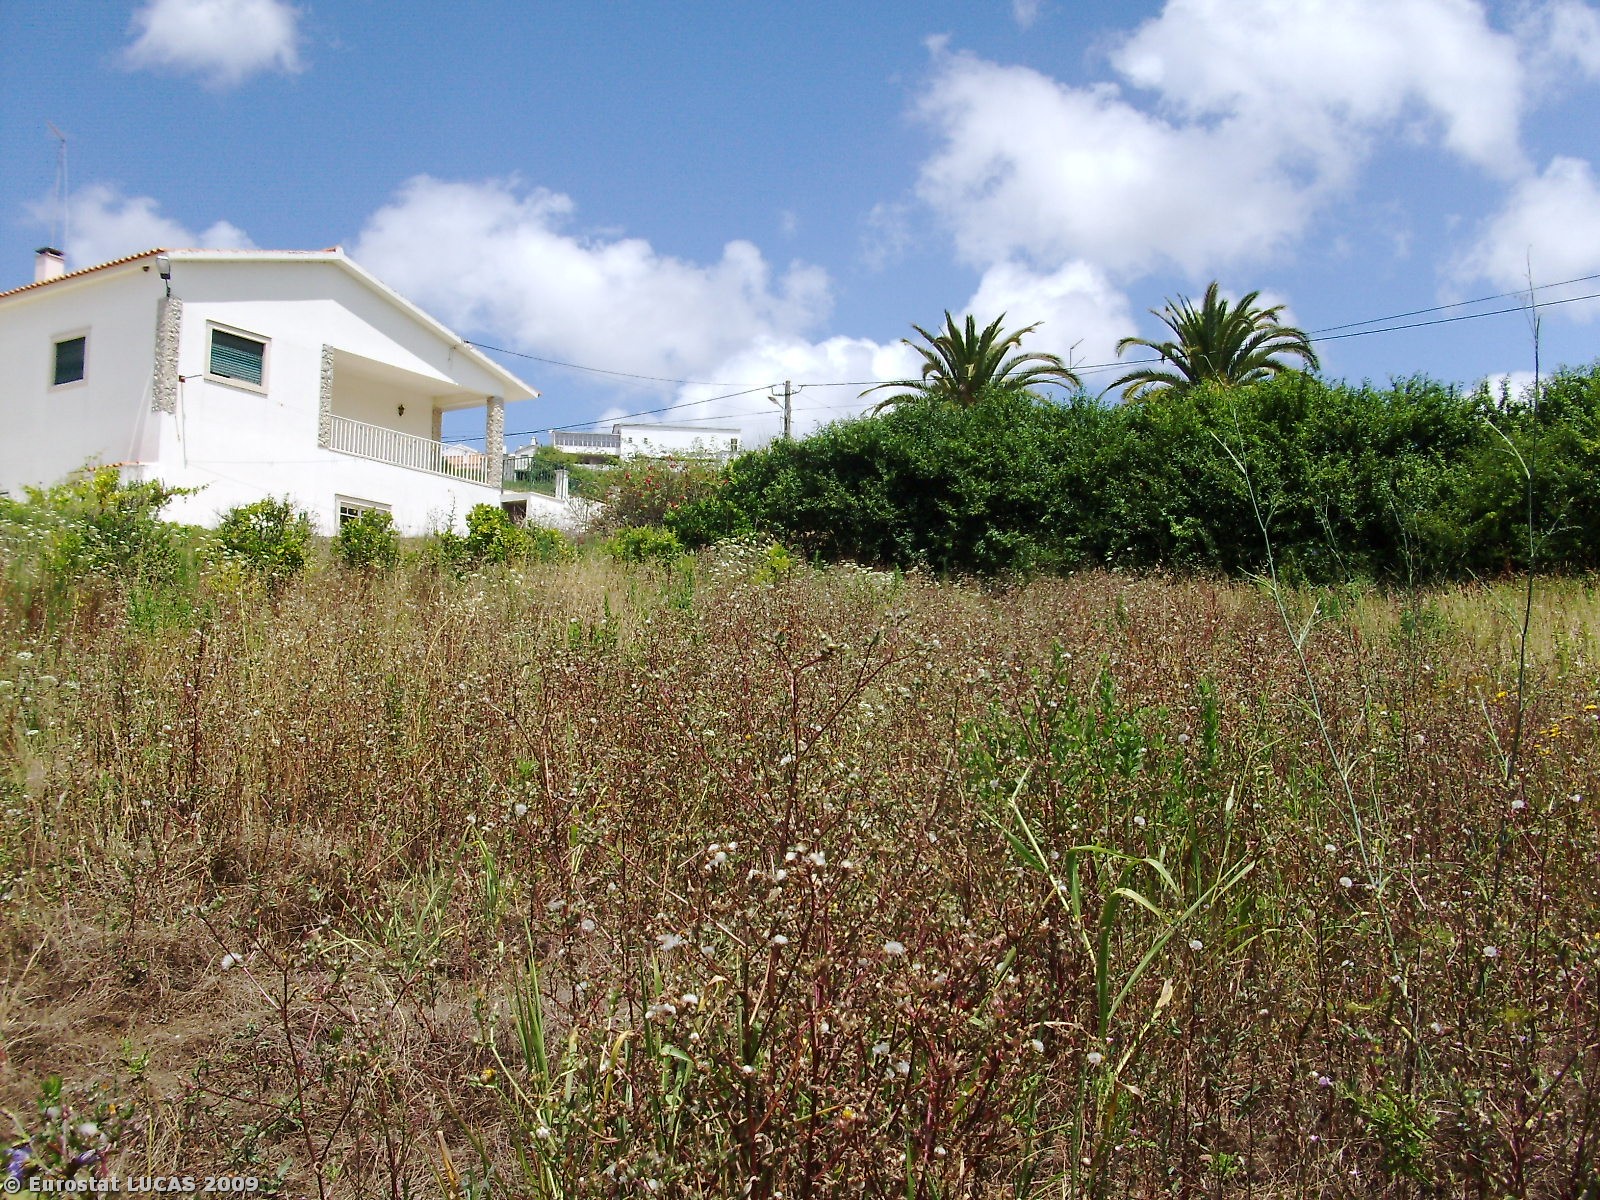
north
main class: Grassland
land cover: Spontaneously vegetated surfaces
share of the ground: > 75 %
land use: Fallow land
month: July
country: PT
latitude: 39.4702
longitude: -9.0702
